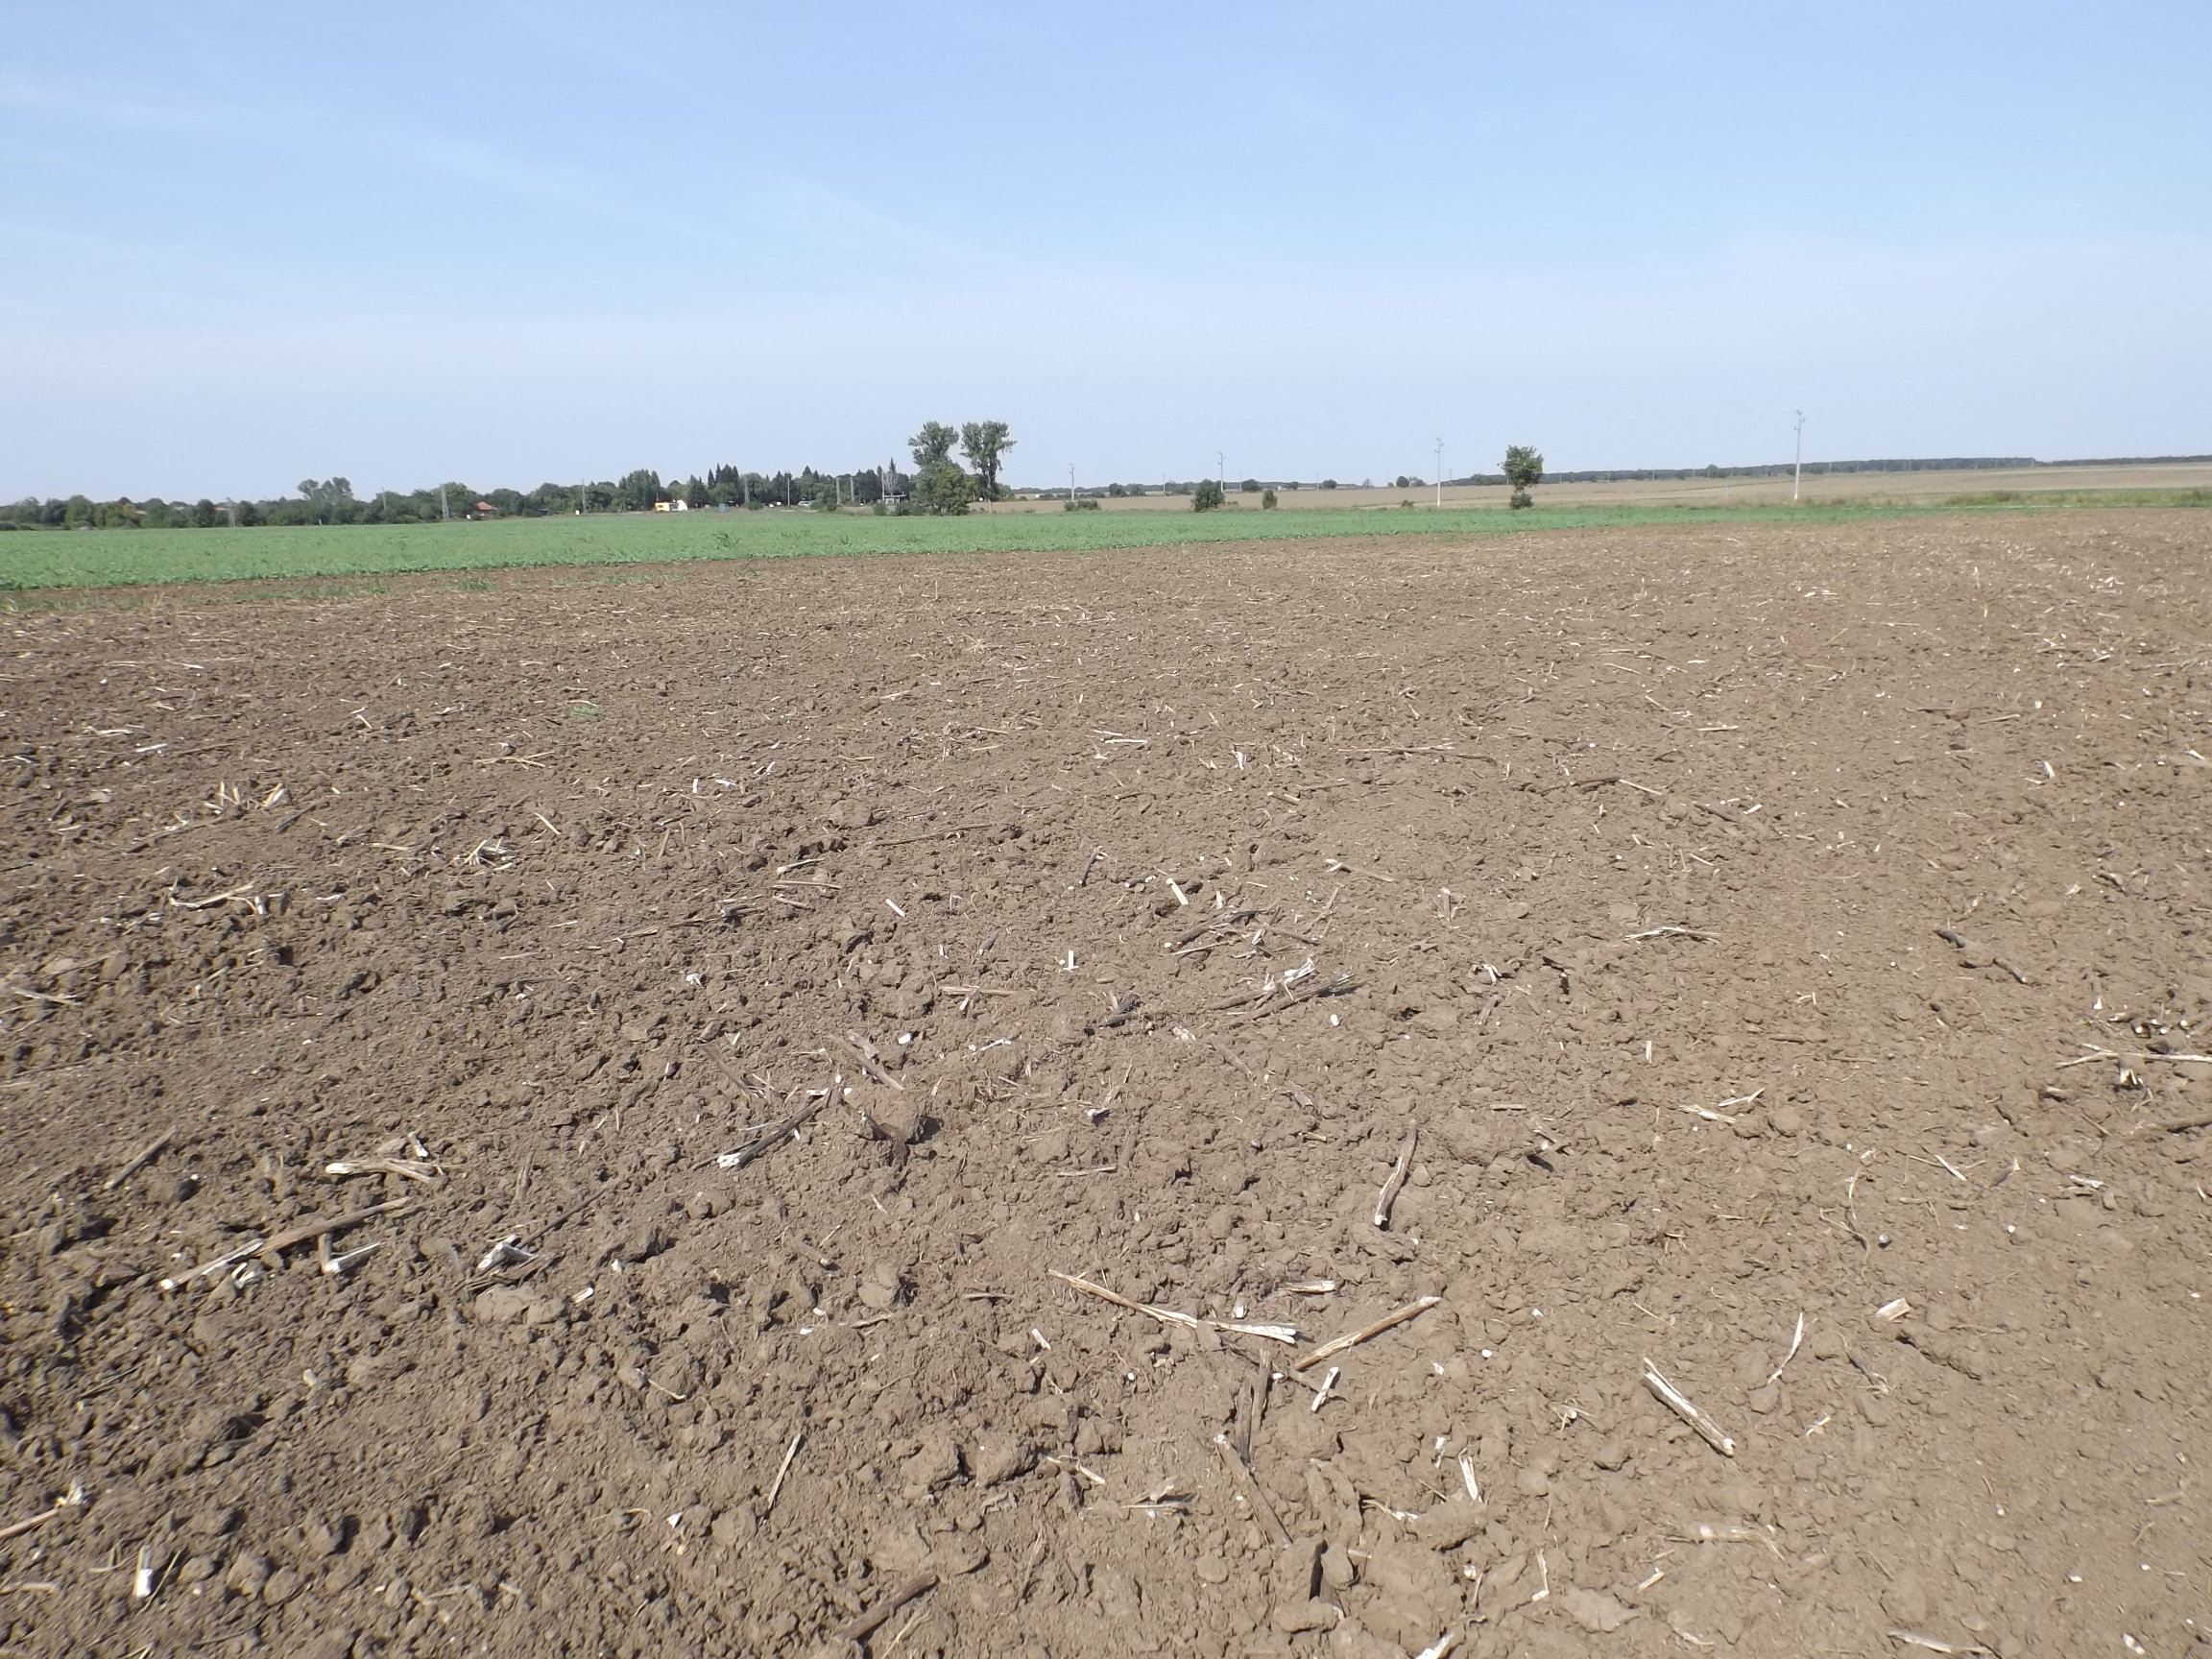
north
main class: Cropland
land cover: Sunflower
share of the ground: < 10 %
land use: Agriculture (excluding fallow land and kitchen gardens)
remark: Harvested field
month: September
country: BG
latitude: 43.9922
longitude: 26.8402
